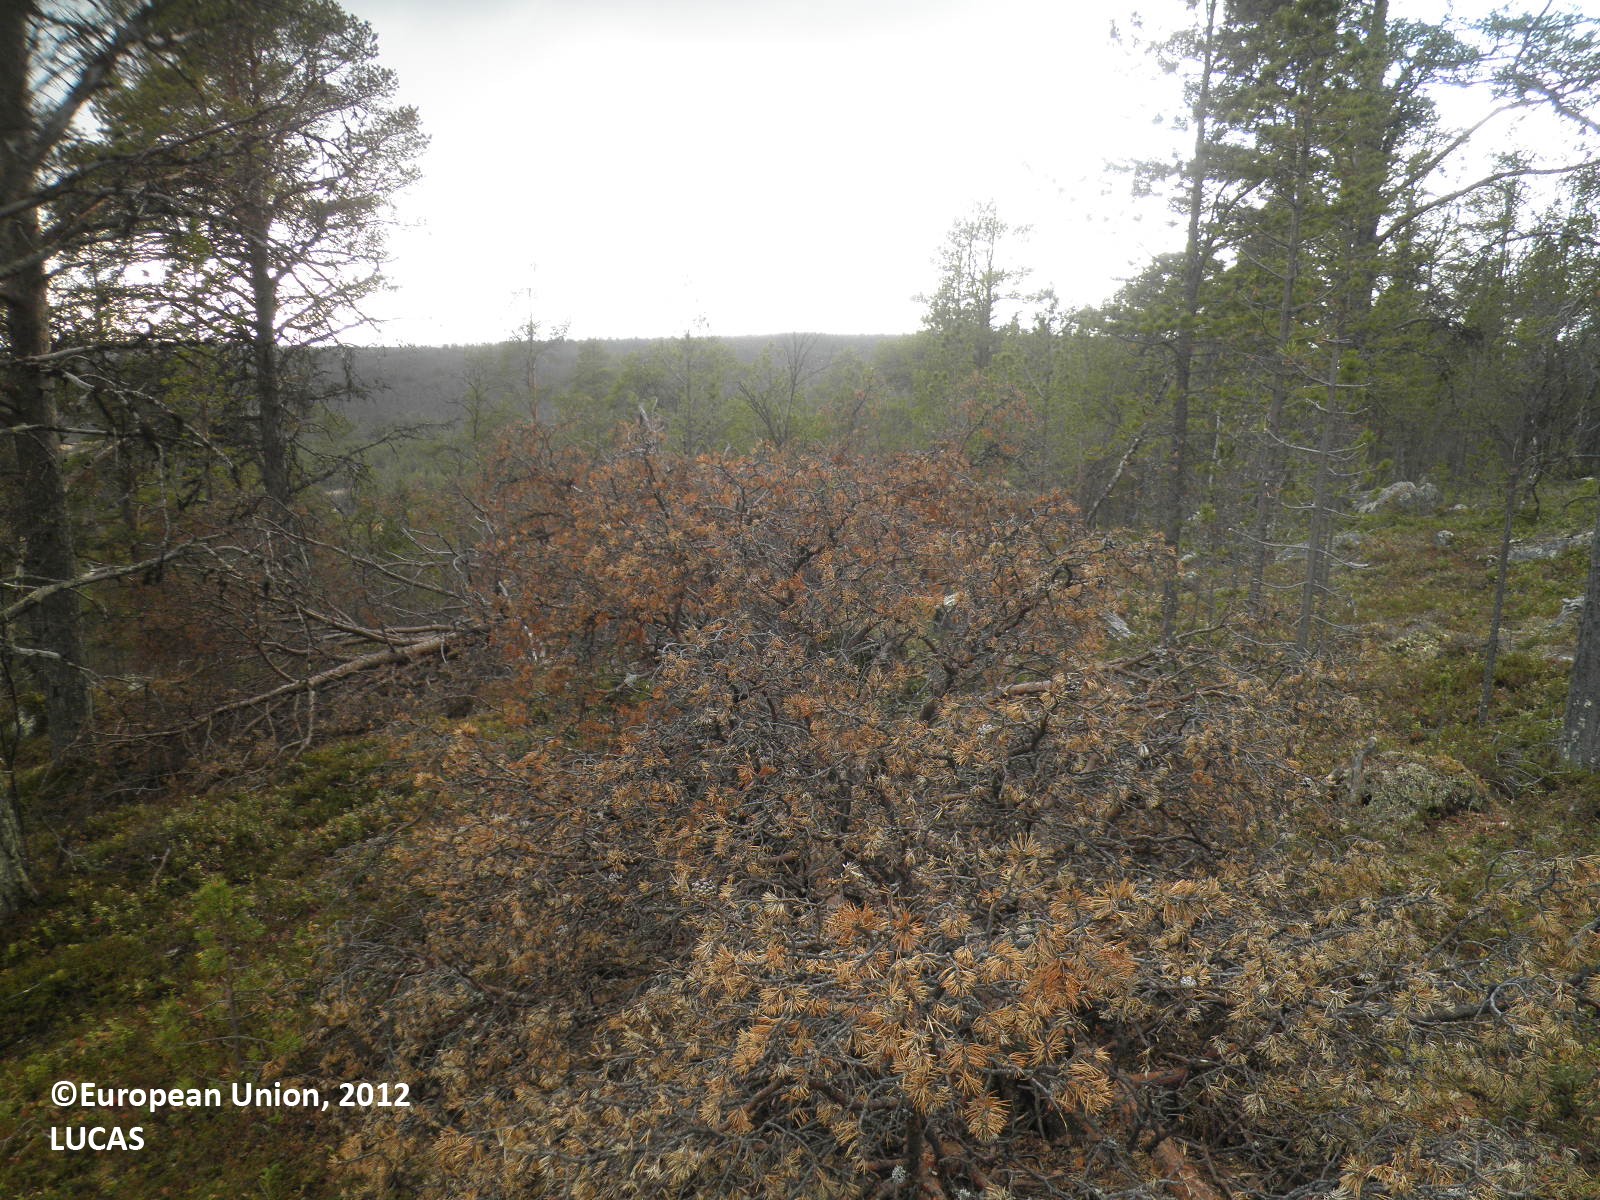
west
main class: Woodland
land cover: Pine dominated mixed woodland
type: boreal forest
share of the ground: > 75 %
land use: Forestry
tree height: > 5 m
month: May
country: FI
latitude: 69.7331
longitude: 27.0396
